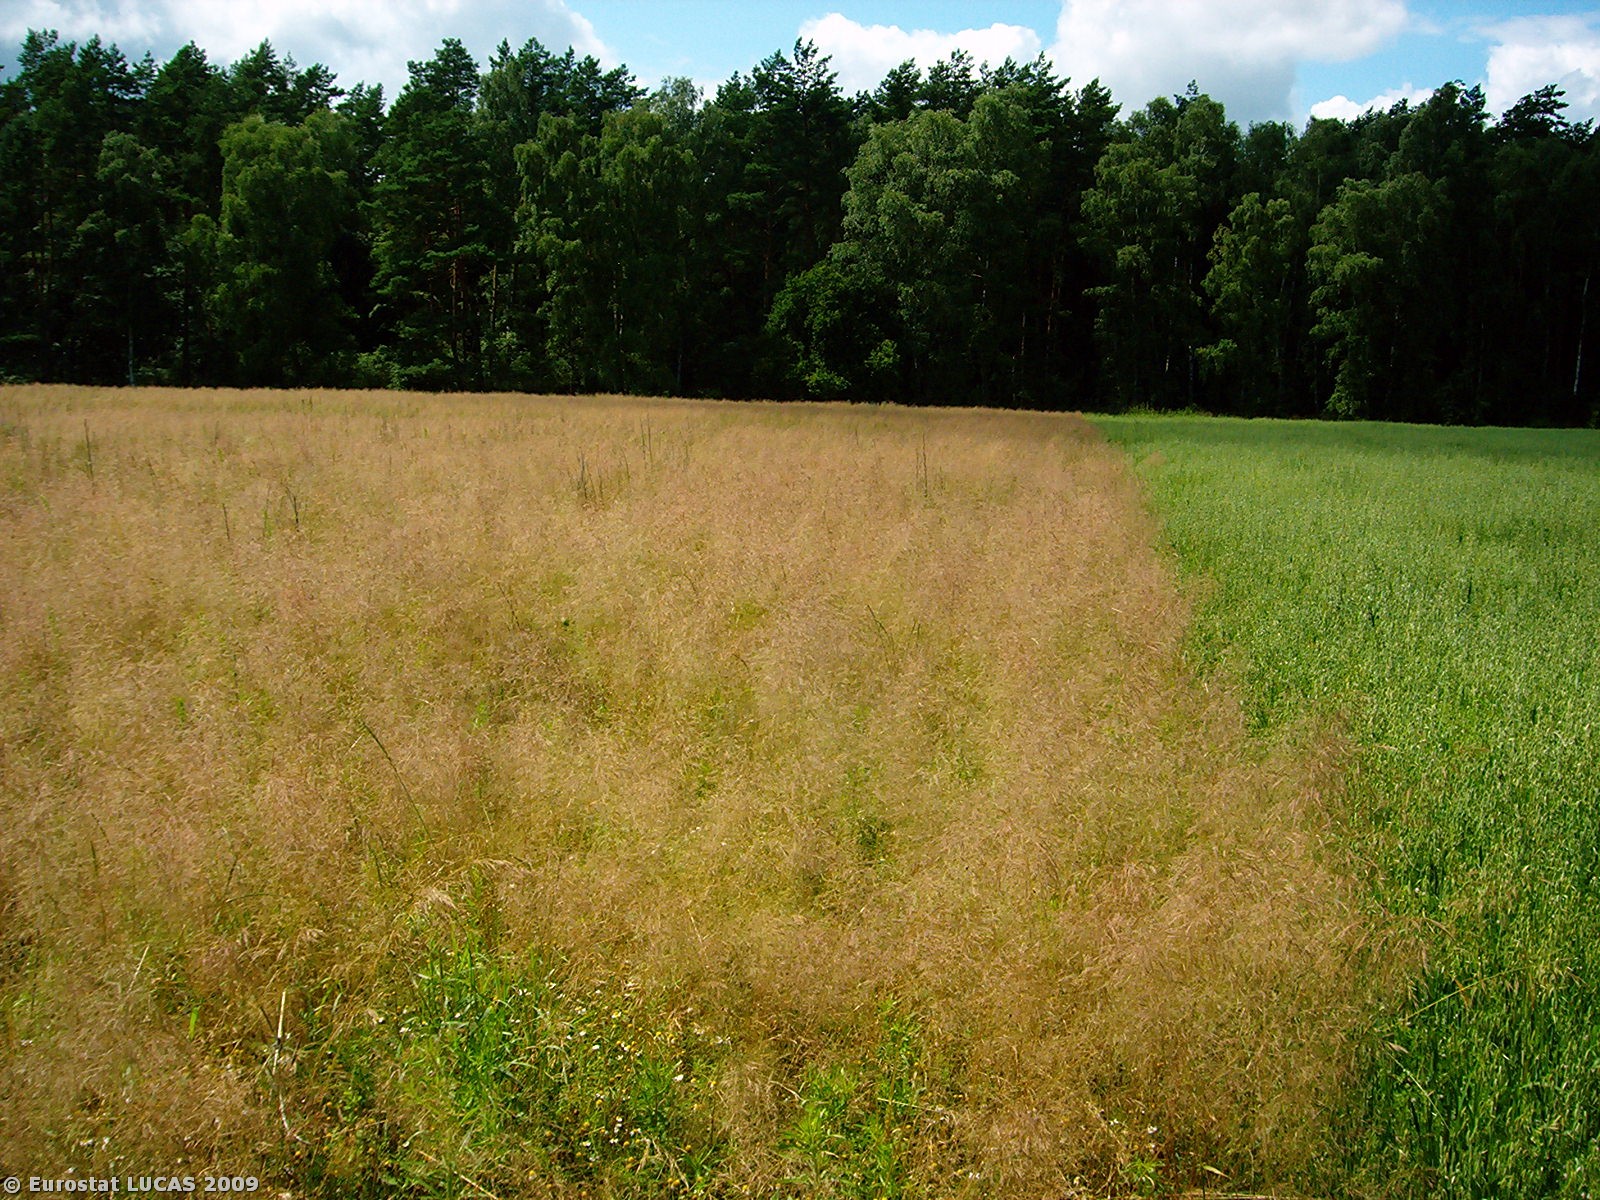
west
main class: Cropland
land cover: Oats
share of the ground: > 75 %
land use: Agriculture (excluding fallow land and kitchen gardens)
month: July
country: PL
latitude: 52.2569
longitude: 15.3508
